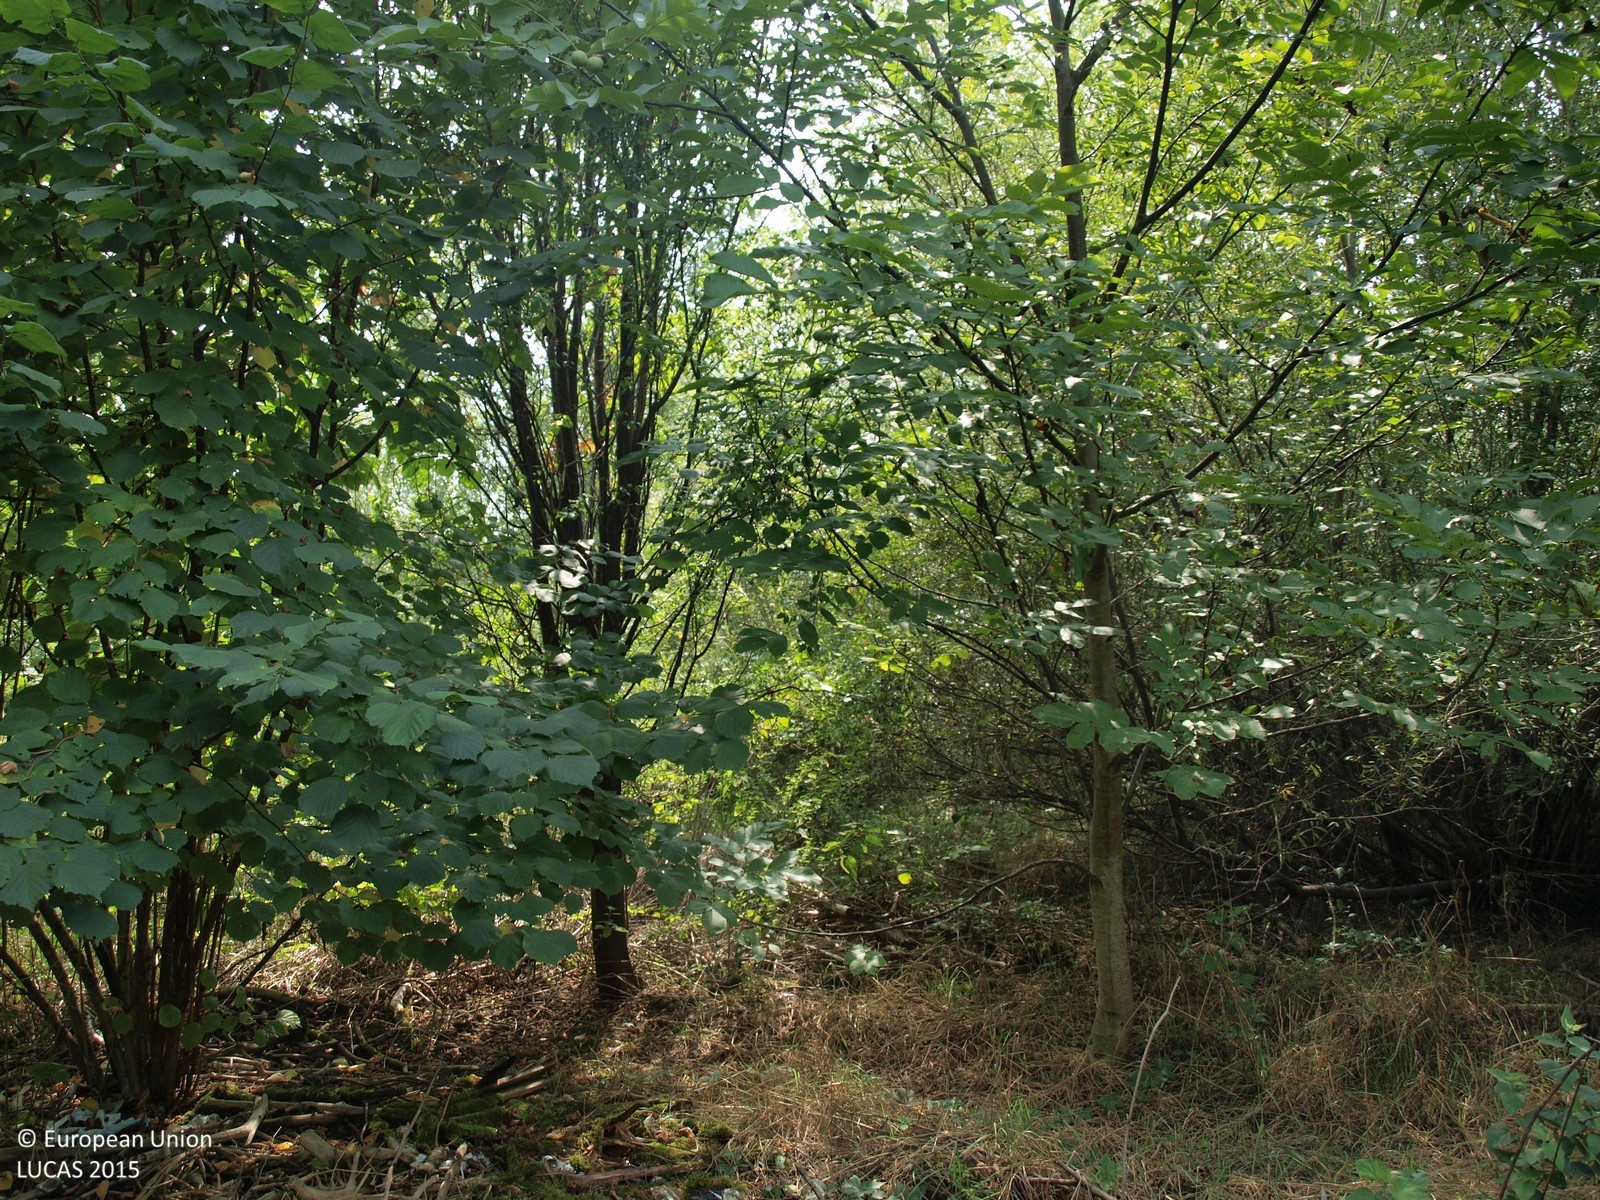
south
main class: Shrubland
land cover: Shrubland with sparse tree cover
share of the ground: > 75 %
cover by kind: shrubs 95 %, broadleaved forest trees 5 %
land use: Semi-natural and natural areas not in use
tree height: > 5 m
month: August
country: HR
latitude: 45.6806
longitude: 16.2506
